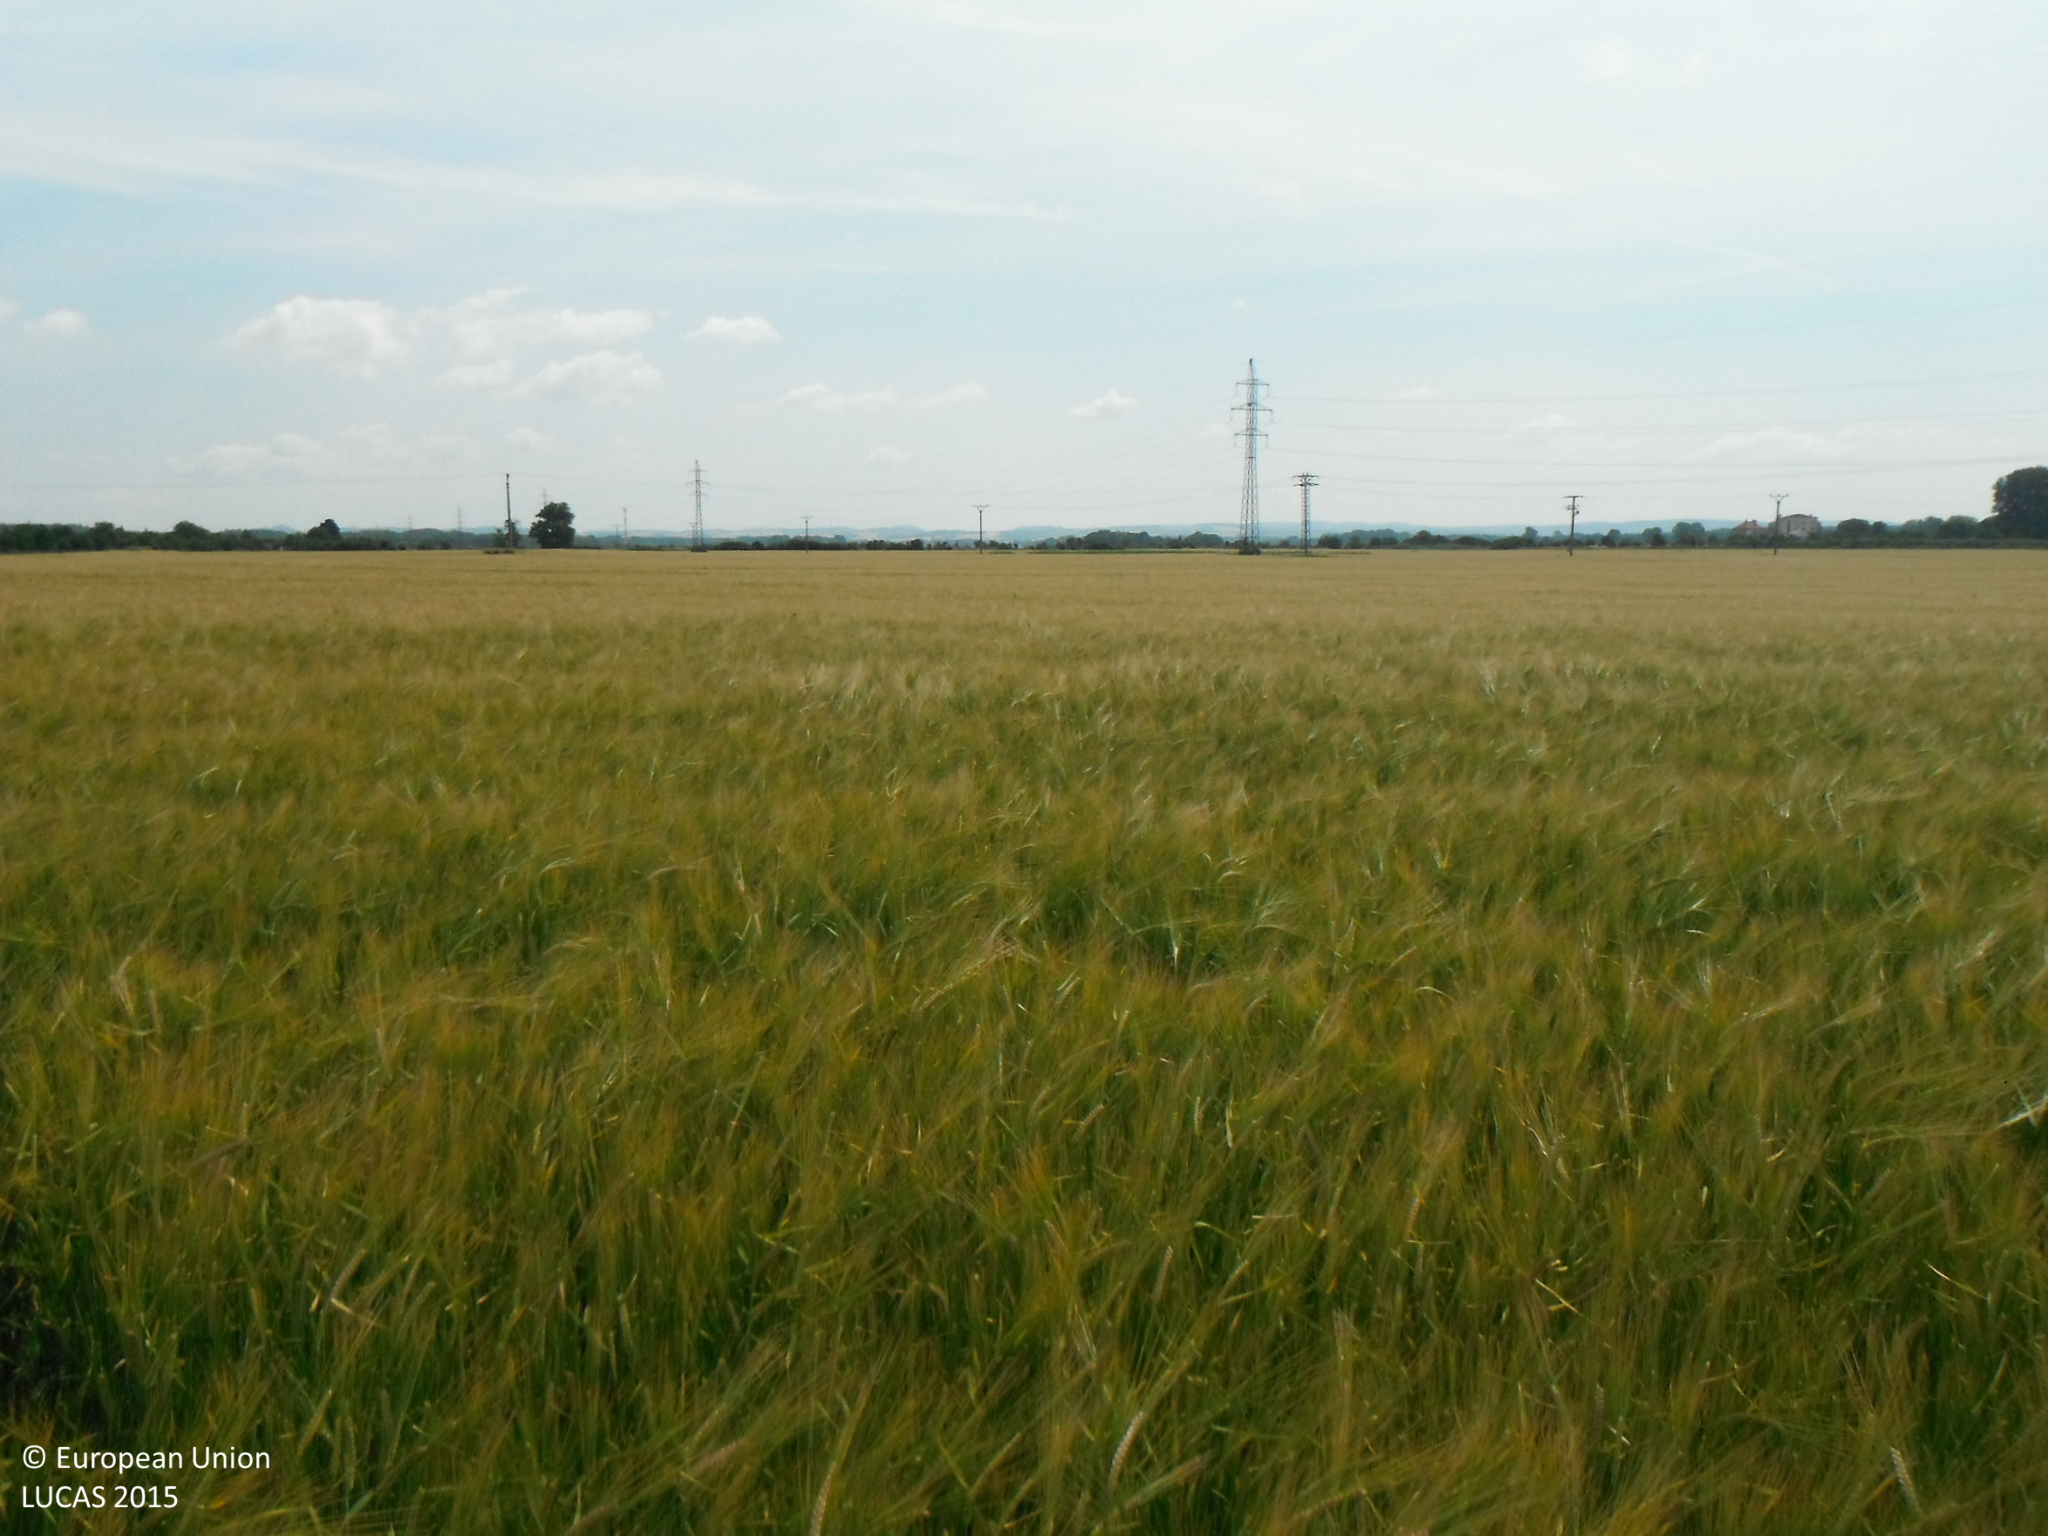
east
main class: Cropland
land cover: Barley
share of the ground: > 75 %
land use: Agriculture (excluding fallow land and kitchen gardens)
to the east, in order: Barley; Electric lines; Barley
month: June
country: SK
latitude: 48.6713
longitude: 17.2475
